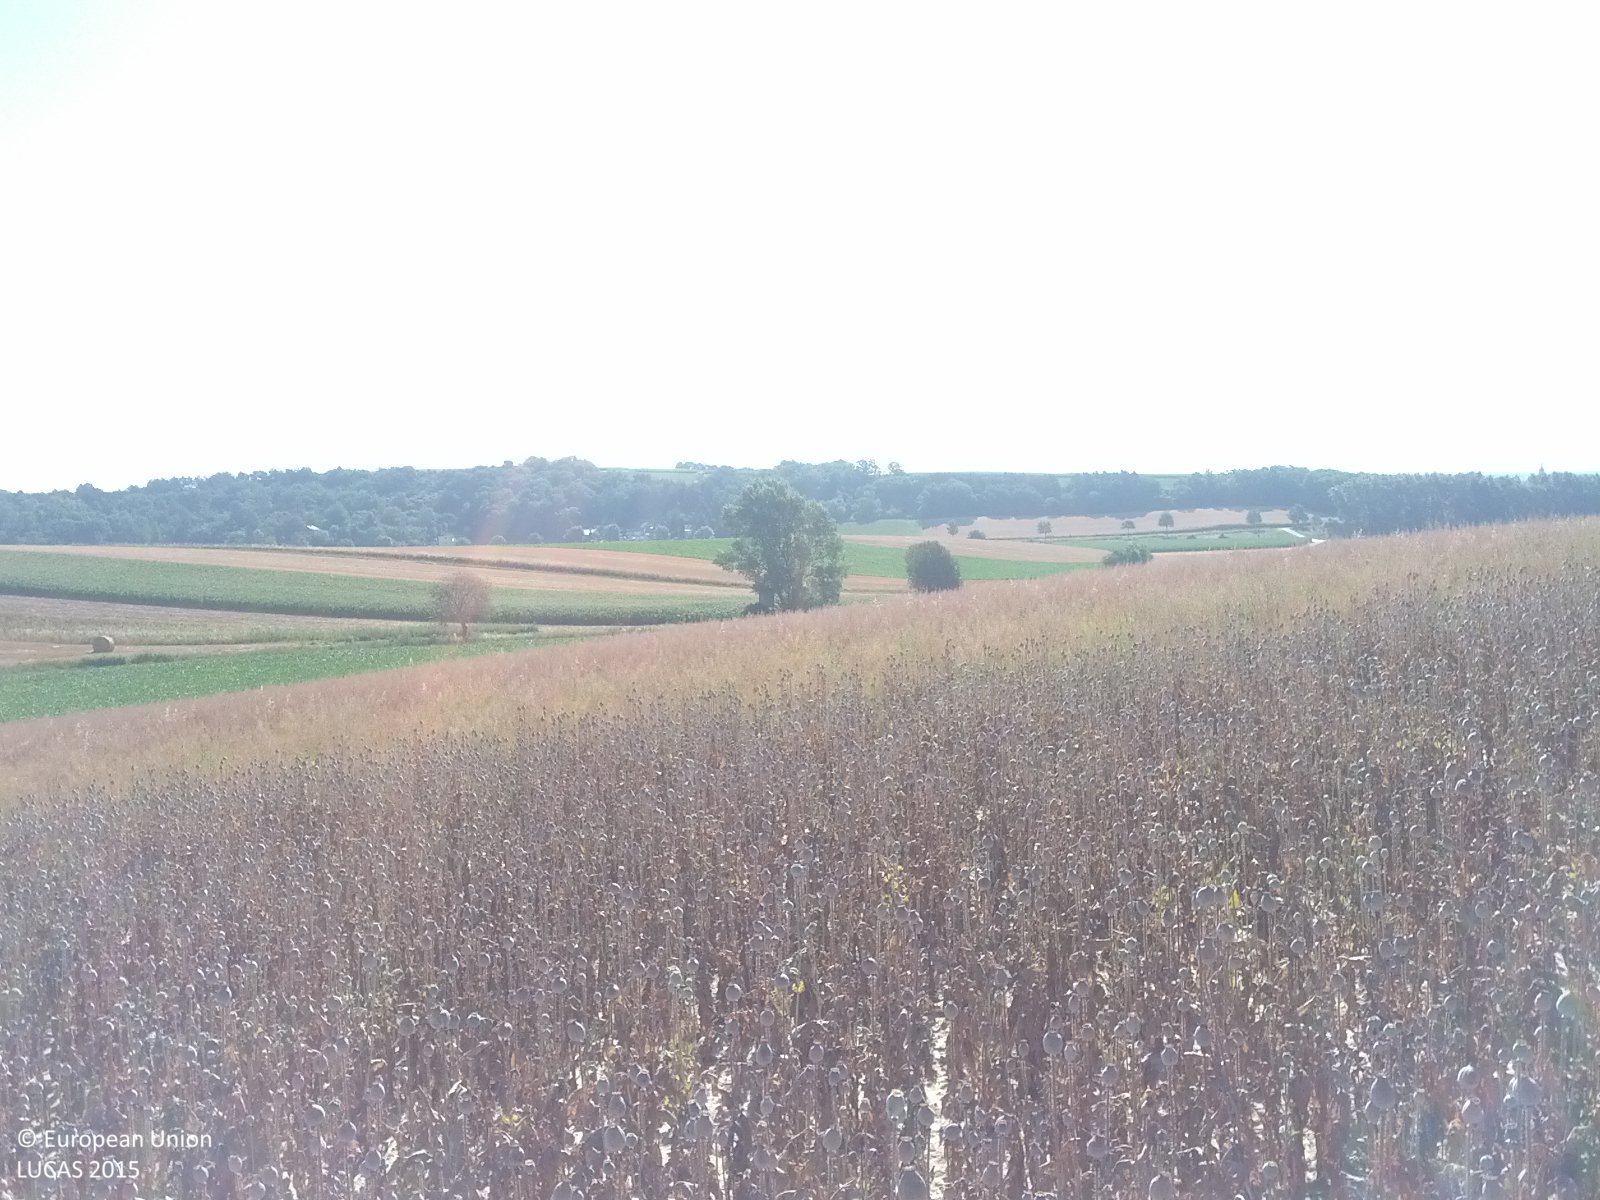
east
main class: Cropland
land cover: Other fibre and oleaginous crops
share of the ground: > 75 %
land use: Agriculture (excluding fallow land and kitchen gardens)
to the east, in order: Other fibre and oleaginous crops; Rape and turnip rape; Common wheat; Sugar beet; Grassland without tree/shrub cover; Tracks; Grass margins; Ditches and canals; Single bushes/trees; Grass margins; Paved roads, cycling and walking lanes; Grass margins; Maize; Common wheat
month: July
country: AT
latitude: 48.4515
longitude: 16.1024
